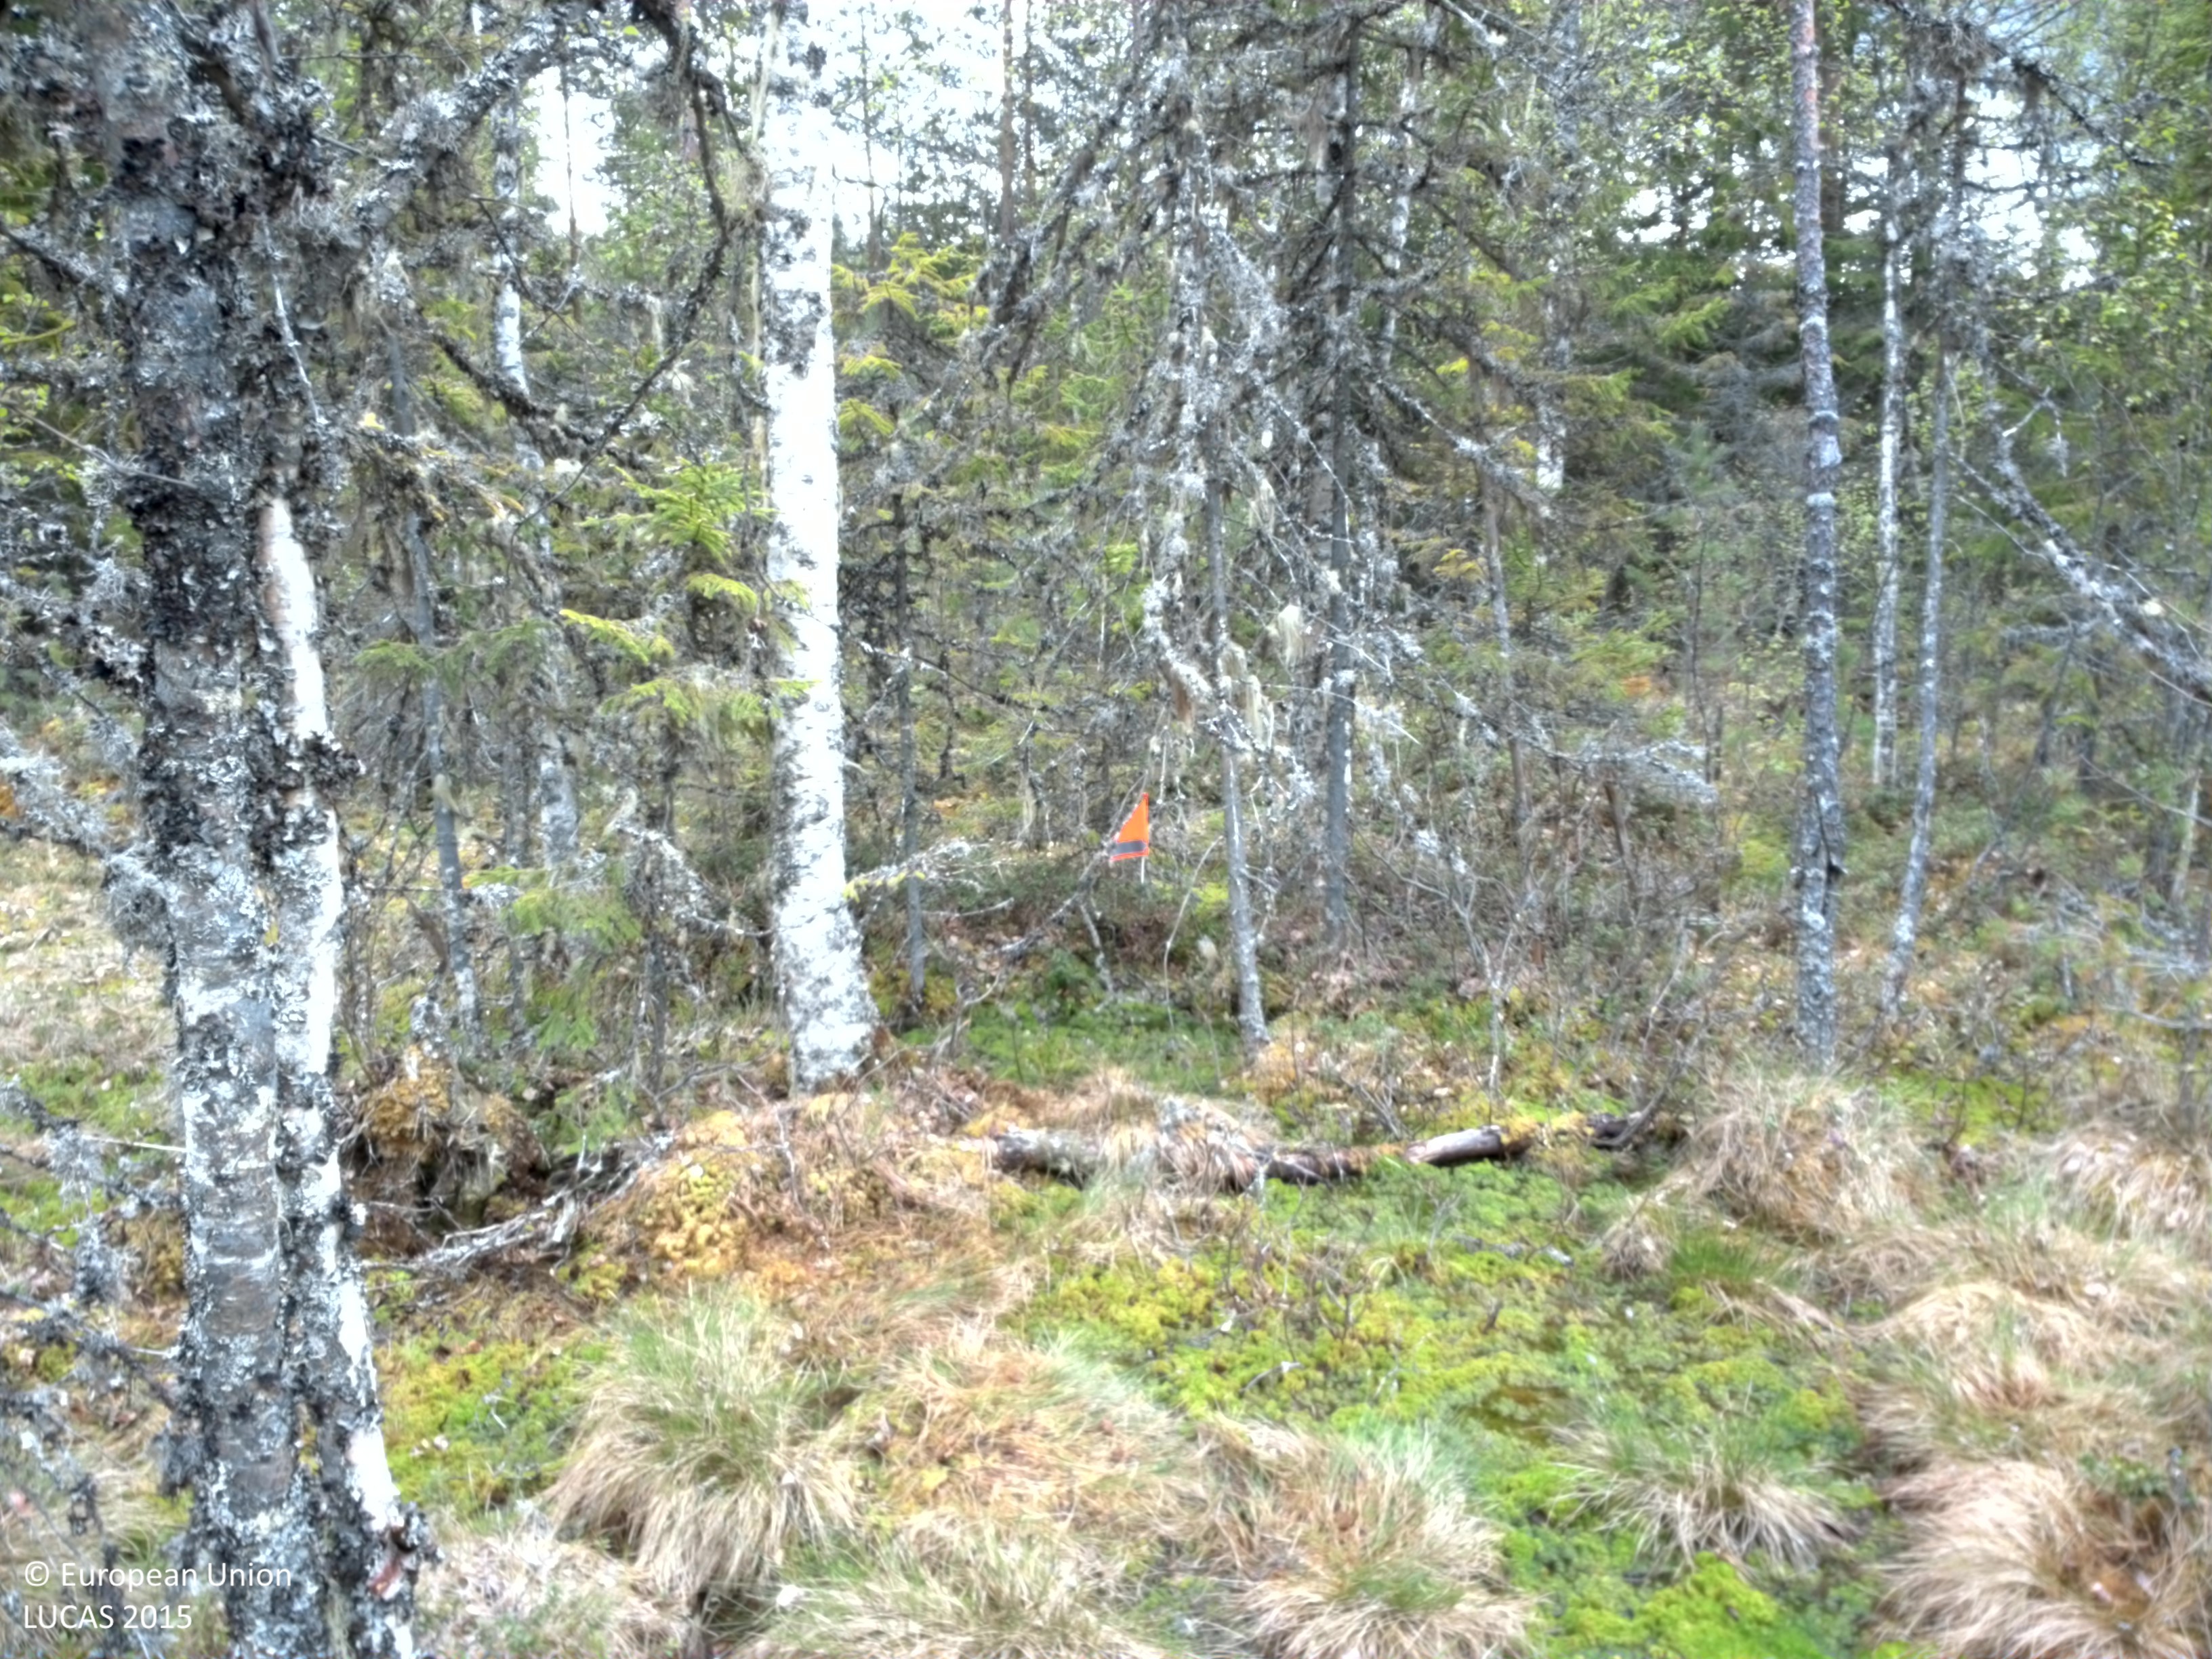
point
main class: Woodland
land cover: Pine dominated mixed woodland
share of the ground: 50 - 75 %
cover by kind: coniferous forest trees 30 %, broadleaved forest trees 30 %, shrubs 15 %, lichens and mosses 15 %, herbaceous plants 10 %
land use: Semi-natural and natural areas not in use
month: May
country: SE
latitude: 60.1832
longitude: 13.0744
